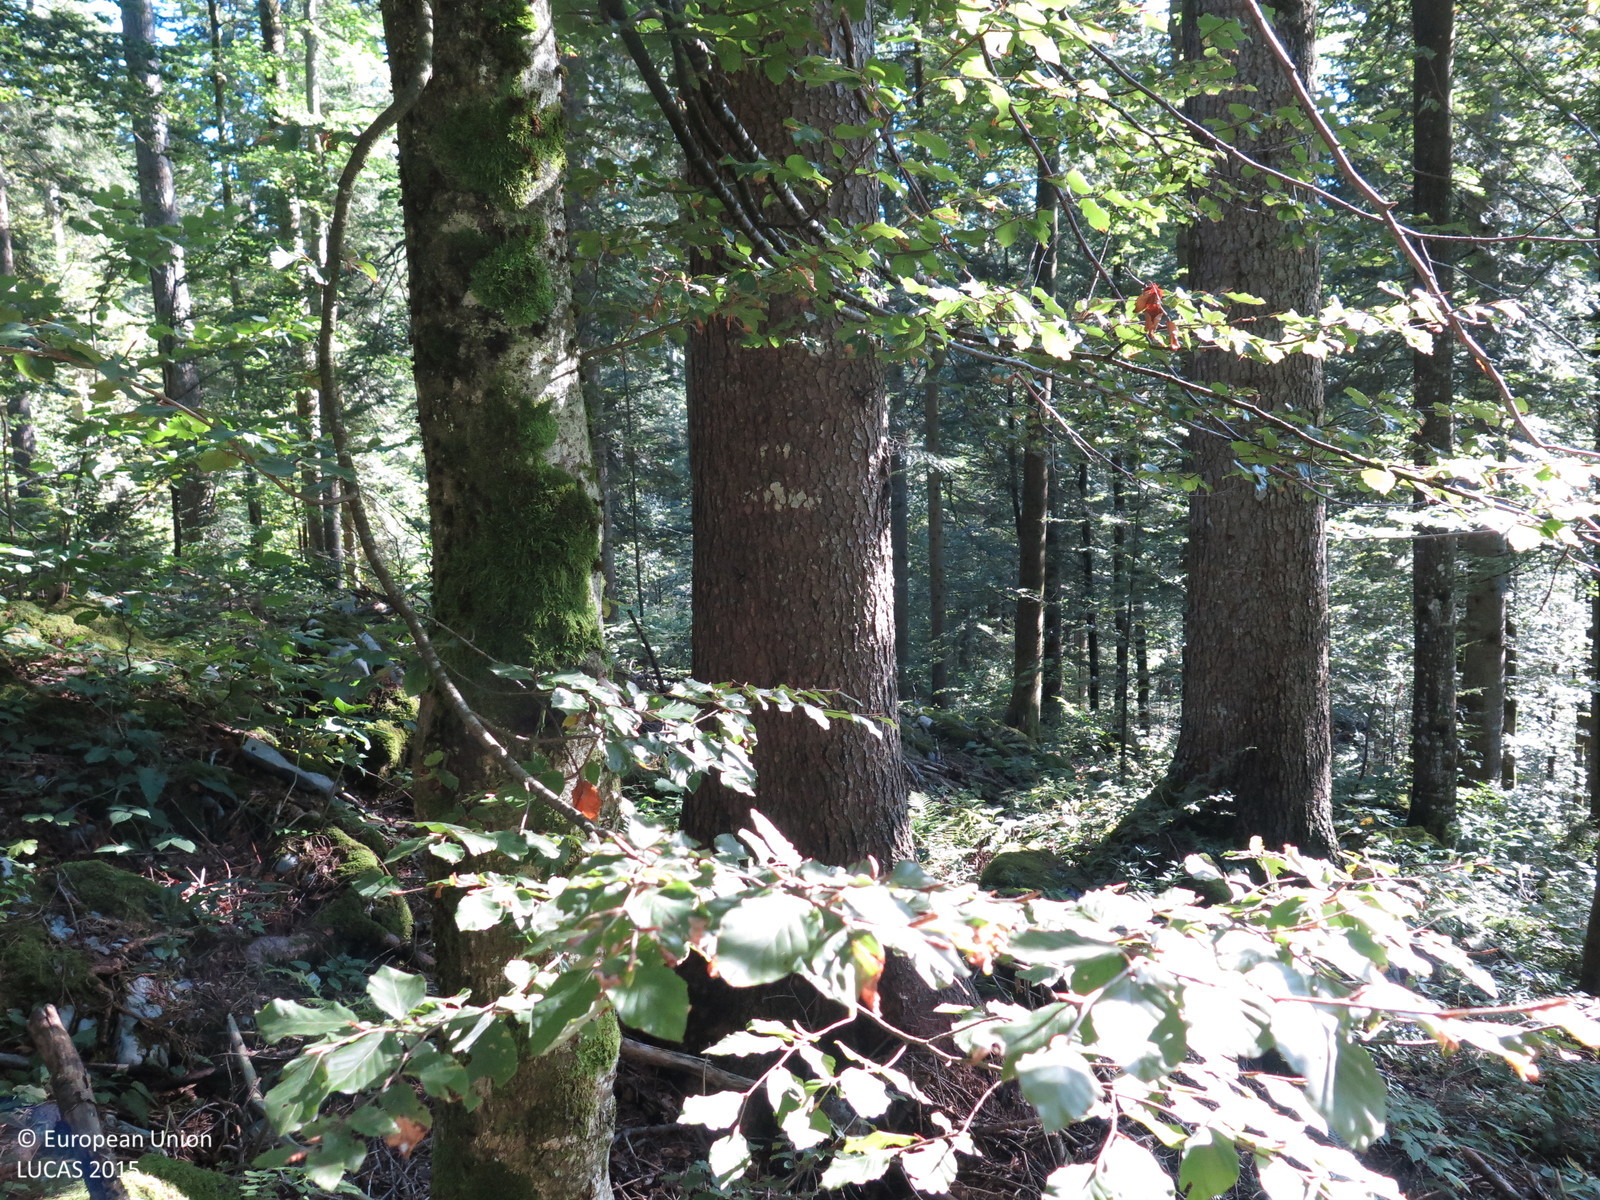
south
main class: Woodland
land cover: Other mixed woodland
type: alpine coniferous forest
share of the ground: > 75 %
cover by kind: coniferous forest trees 75 %, broadleaved forest trees 25 %
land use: Forestry
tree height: > 5 m
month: September
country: HR
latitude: 45.4522
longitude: 14.7393
